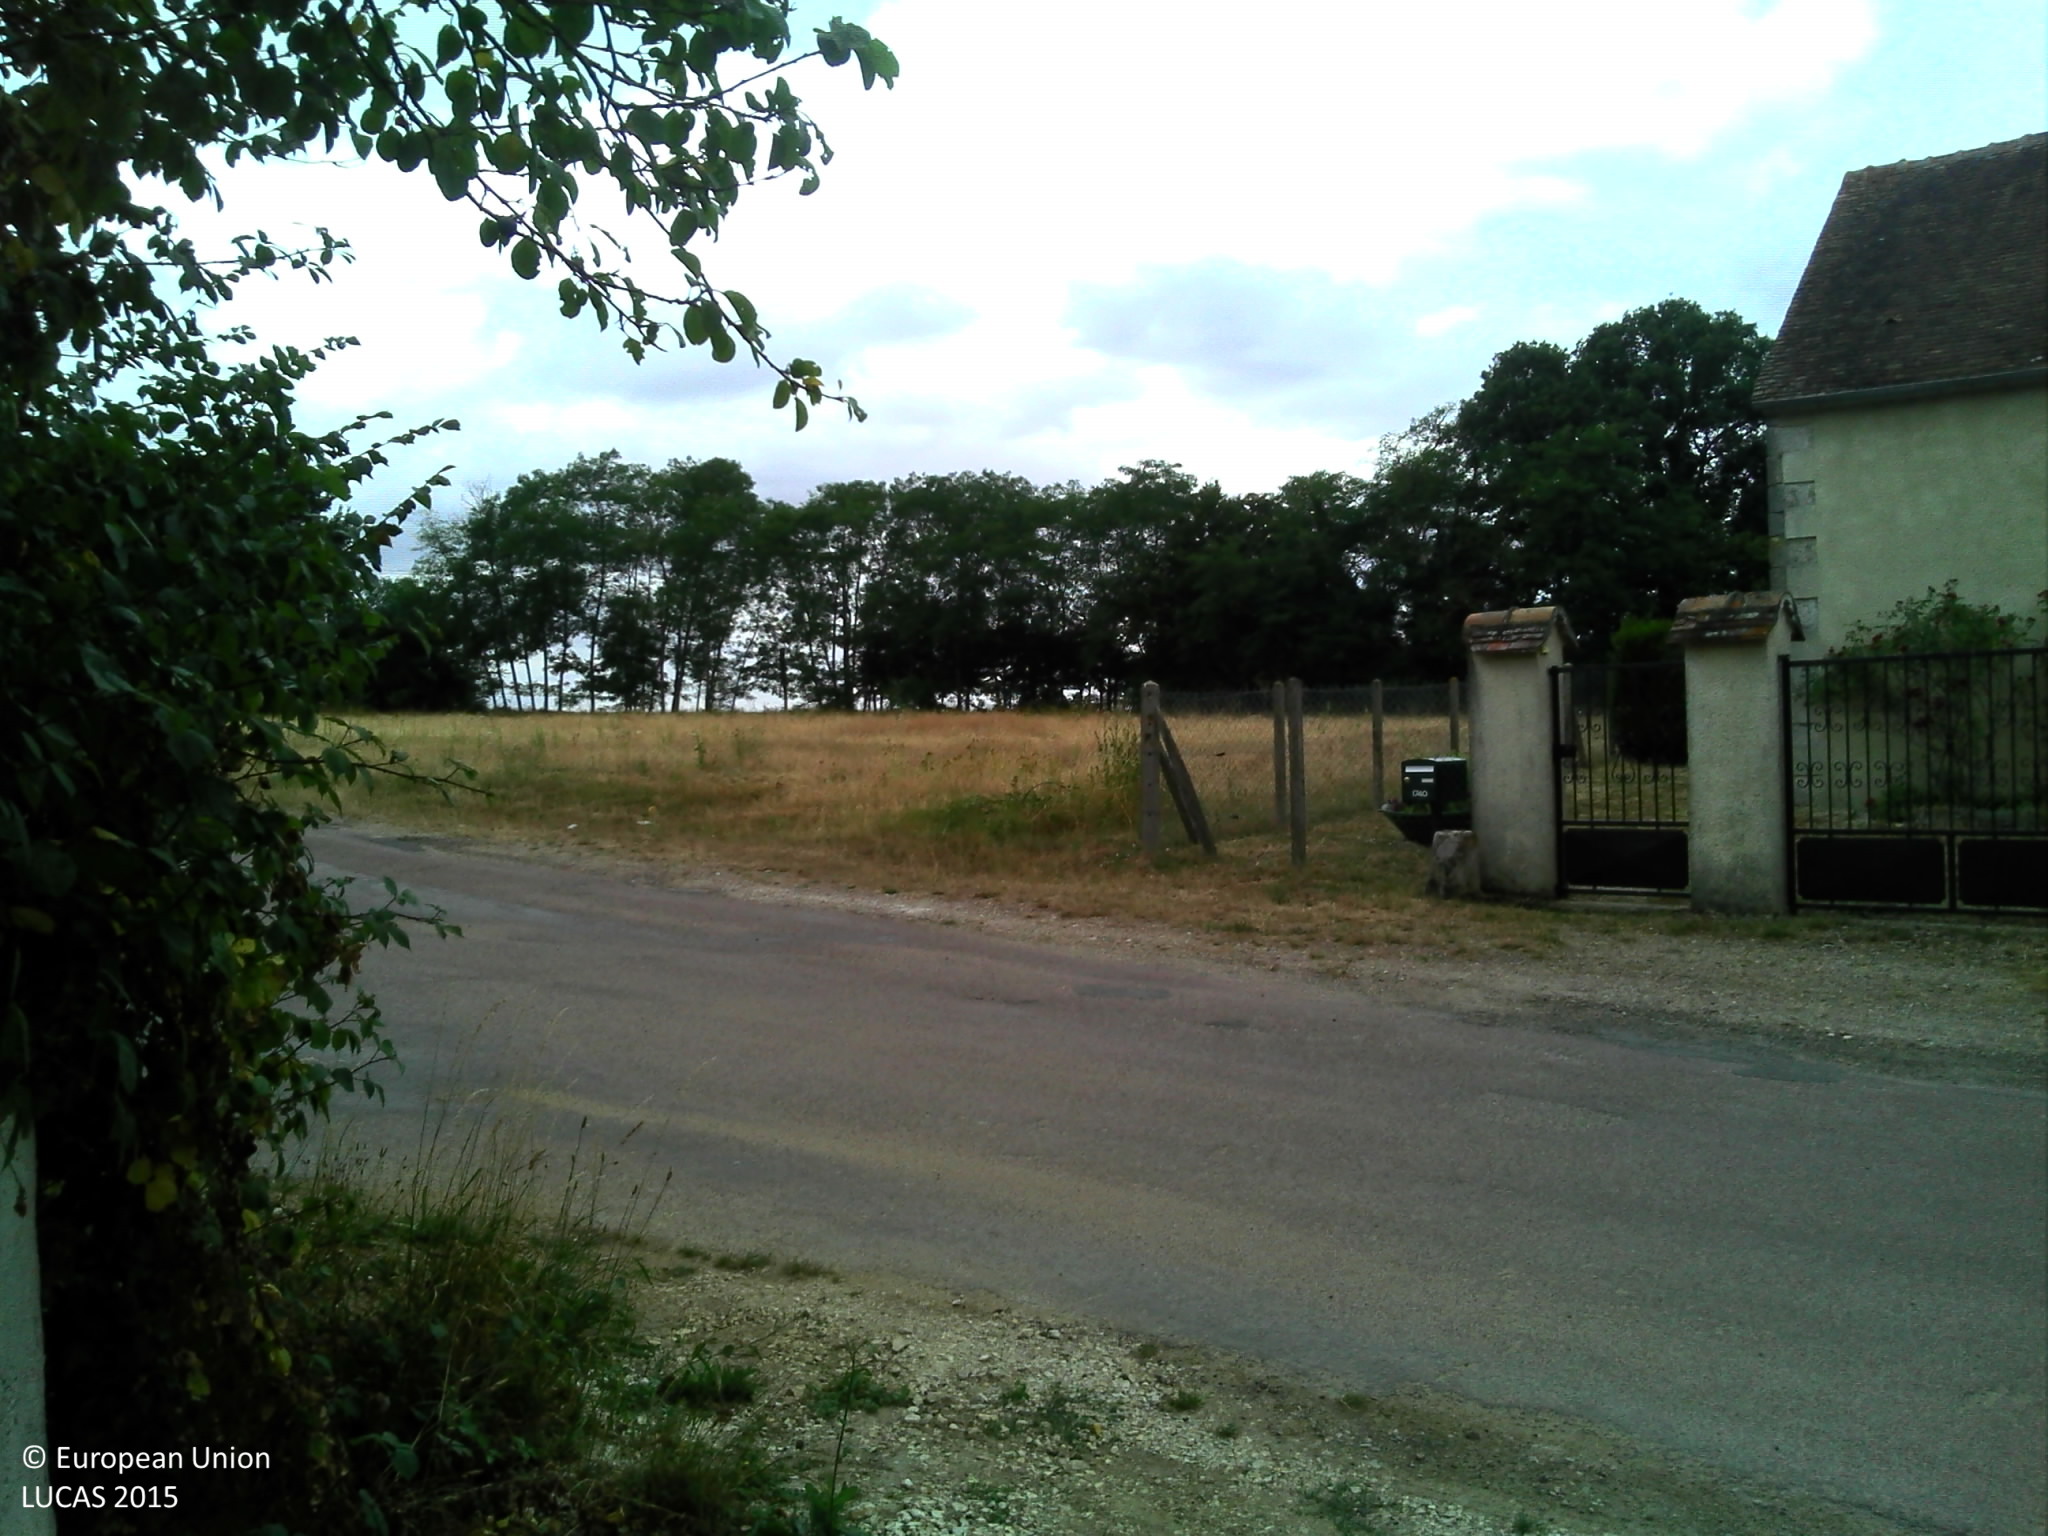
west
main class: Woodland
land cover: Broadleaved woodland
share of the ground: > 75 %
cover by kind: broadleaved forest trees 100 %
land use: Residential
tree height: > 5 m
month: July
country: FR
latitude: 48.0934
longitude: 2.7545
